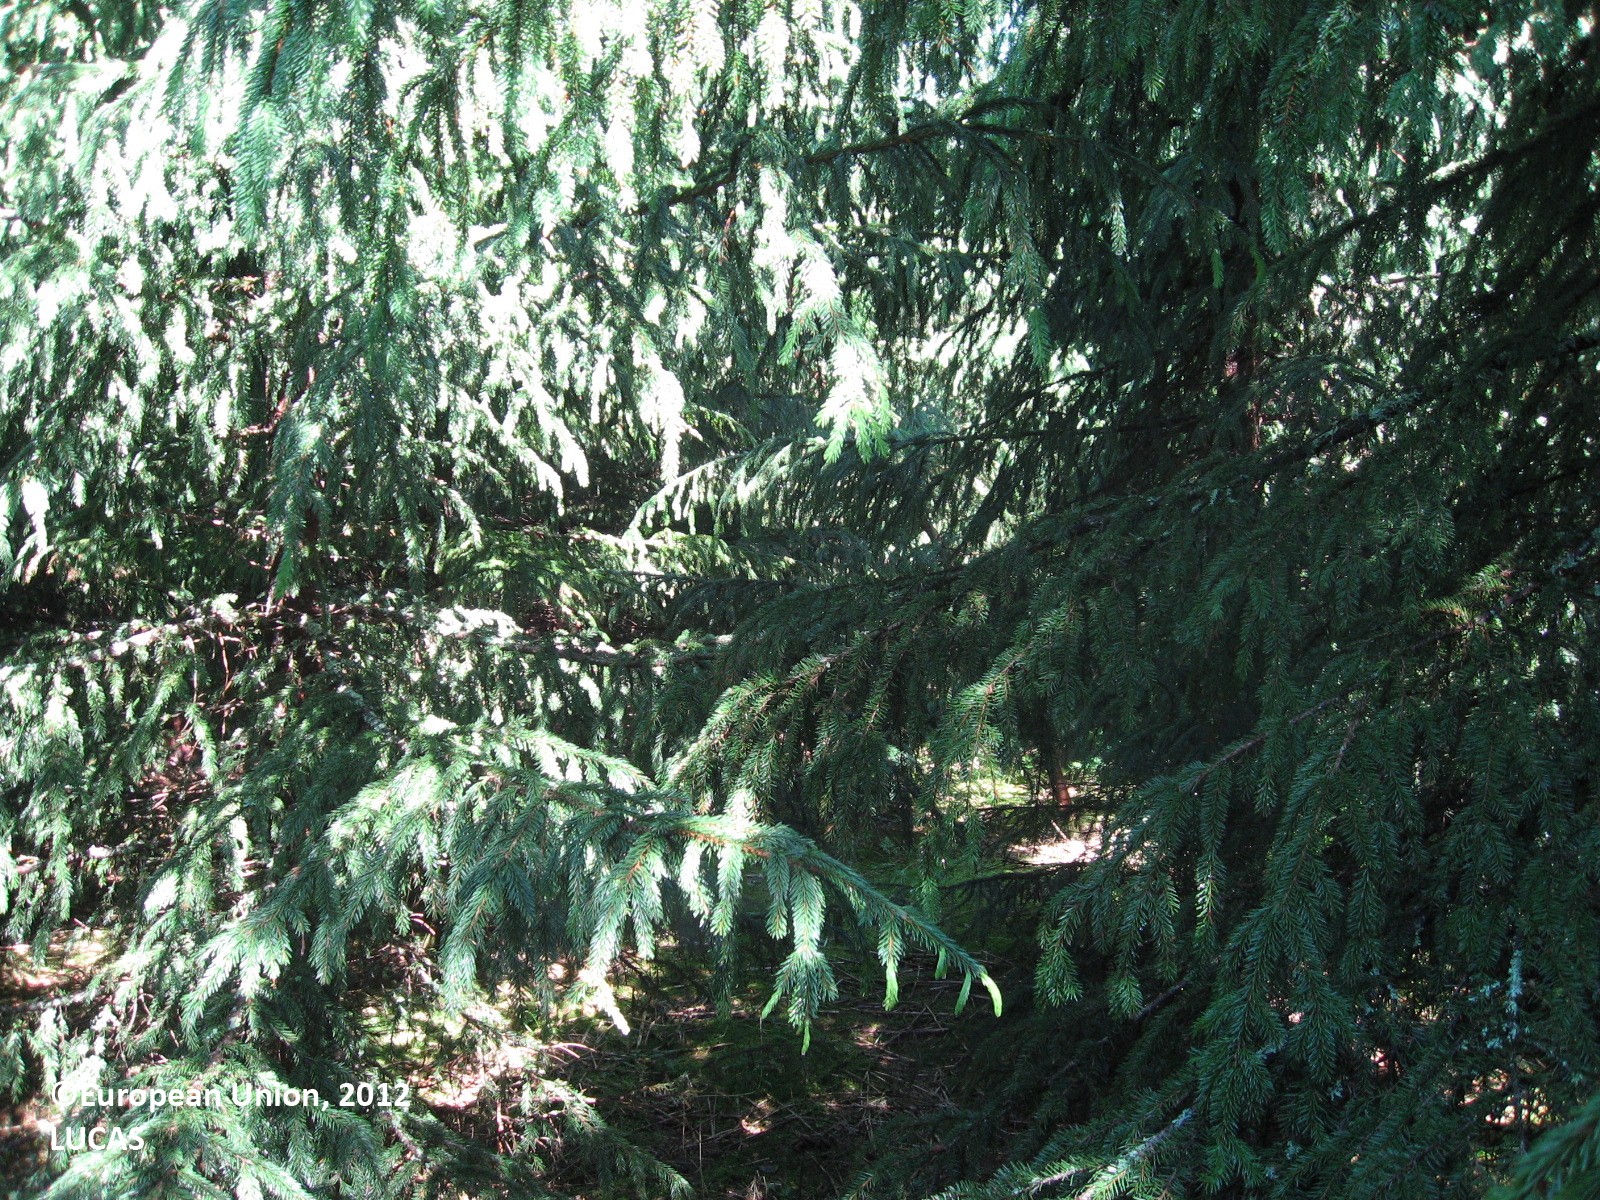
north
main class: Woodland
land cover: Spruce dominated coniferous woodland
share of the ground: > 75 %
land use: Forestry
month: June
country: FI
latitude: 60.5357
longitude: 26.4292
